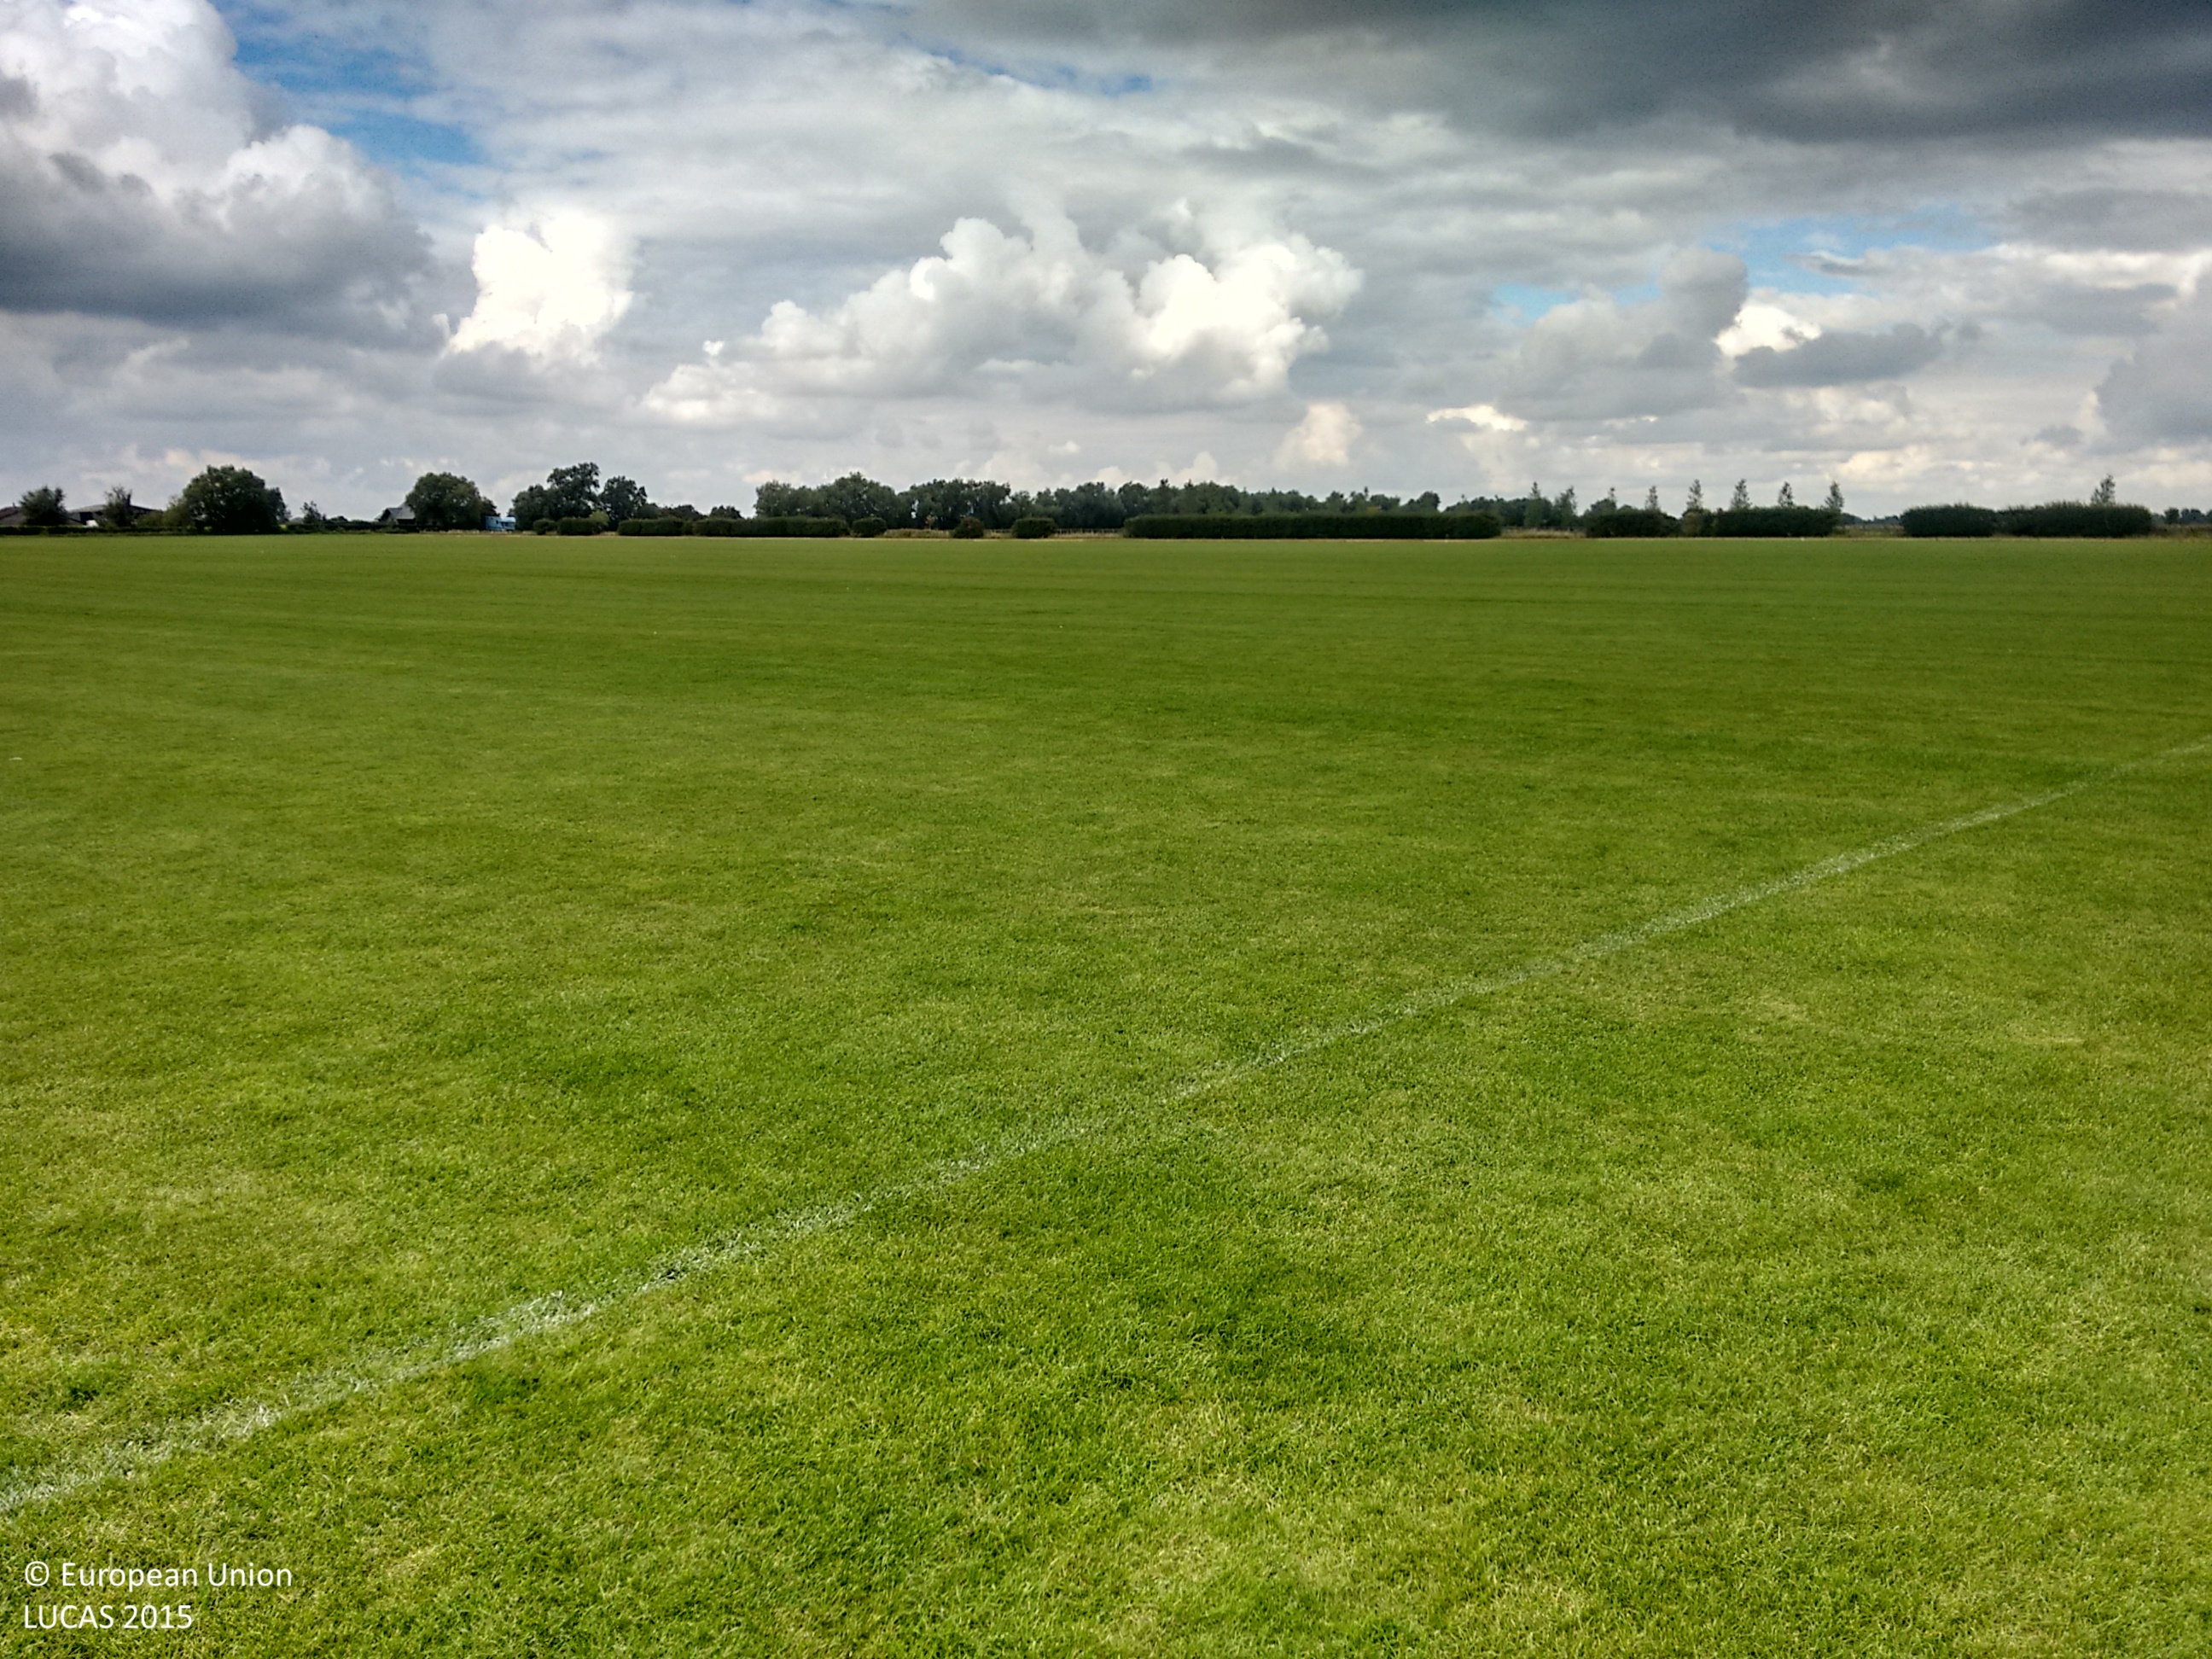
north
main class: Grassland
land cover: Grassland without tree/shrub cover
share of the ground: > 75 %
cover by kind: herbaceous plants 100 %
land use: Sport
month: September
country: GB
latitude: 52.2630
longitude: 0.2261
